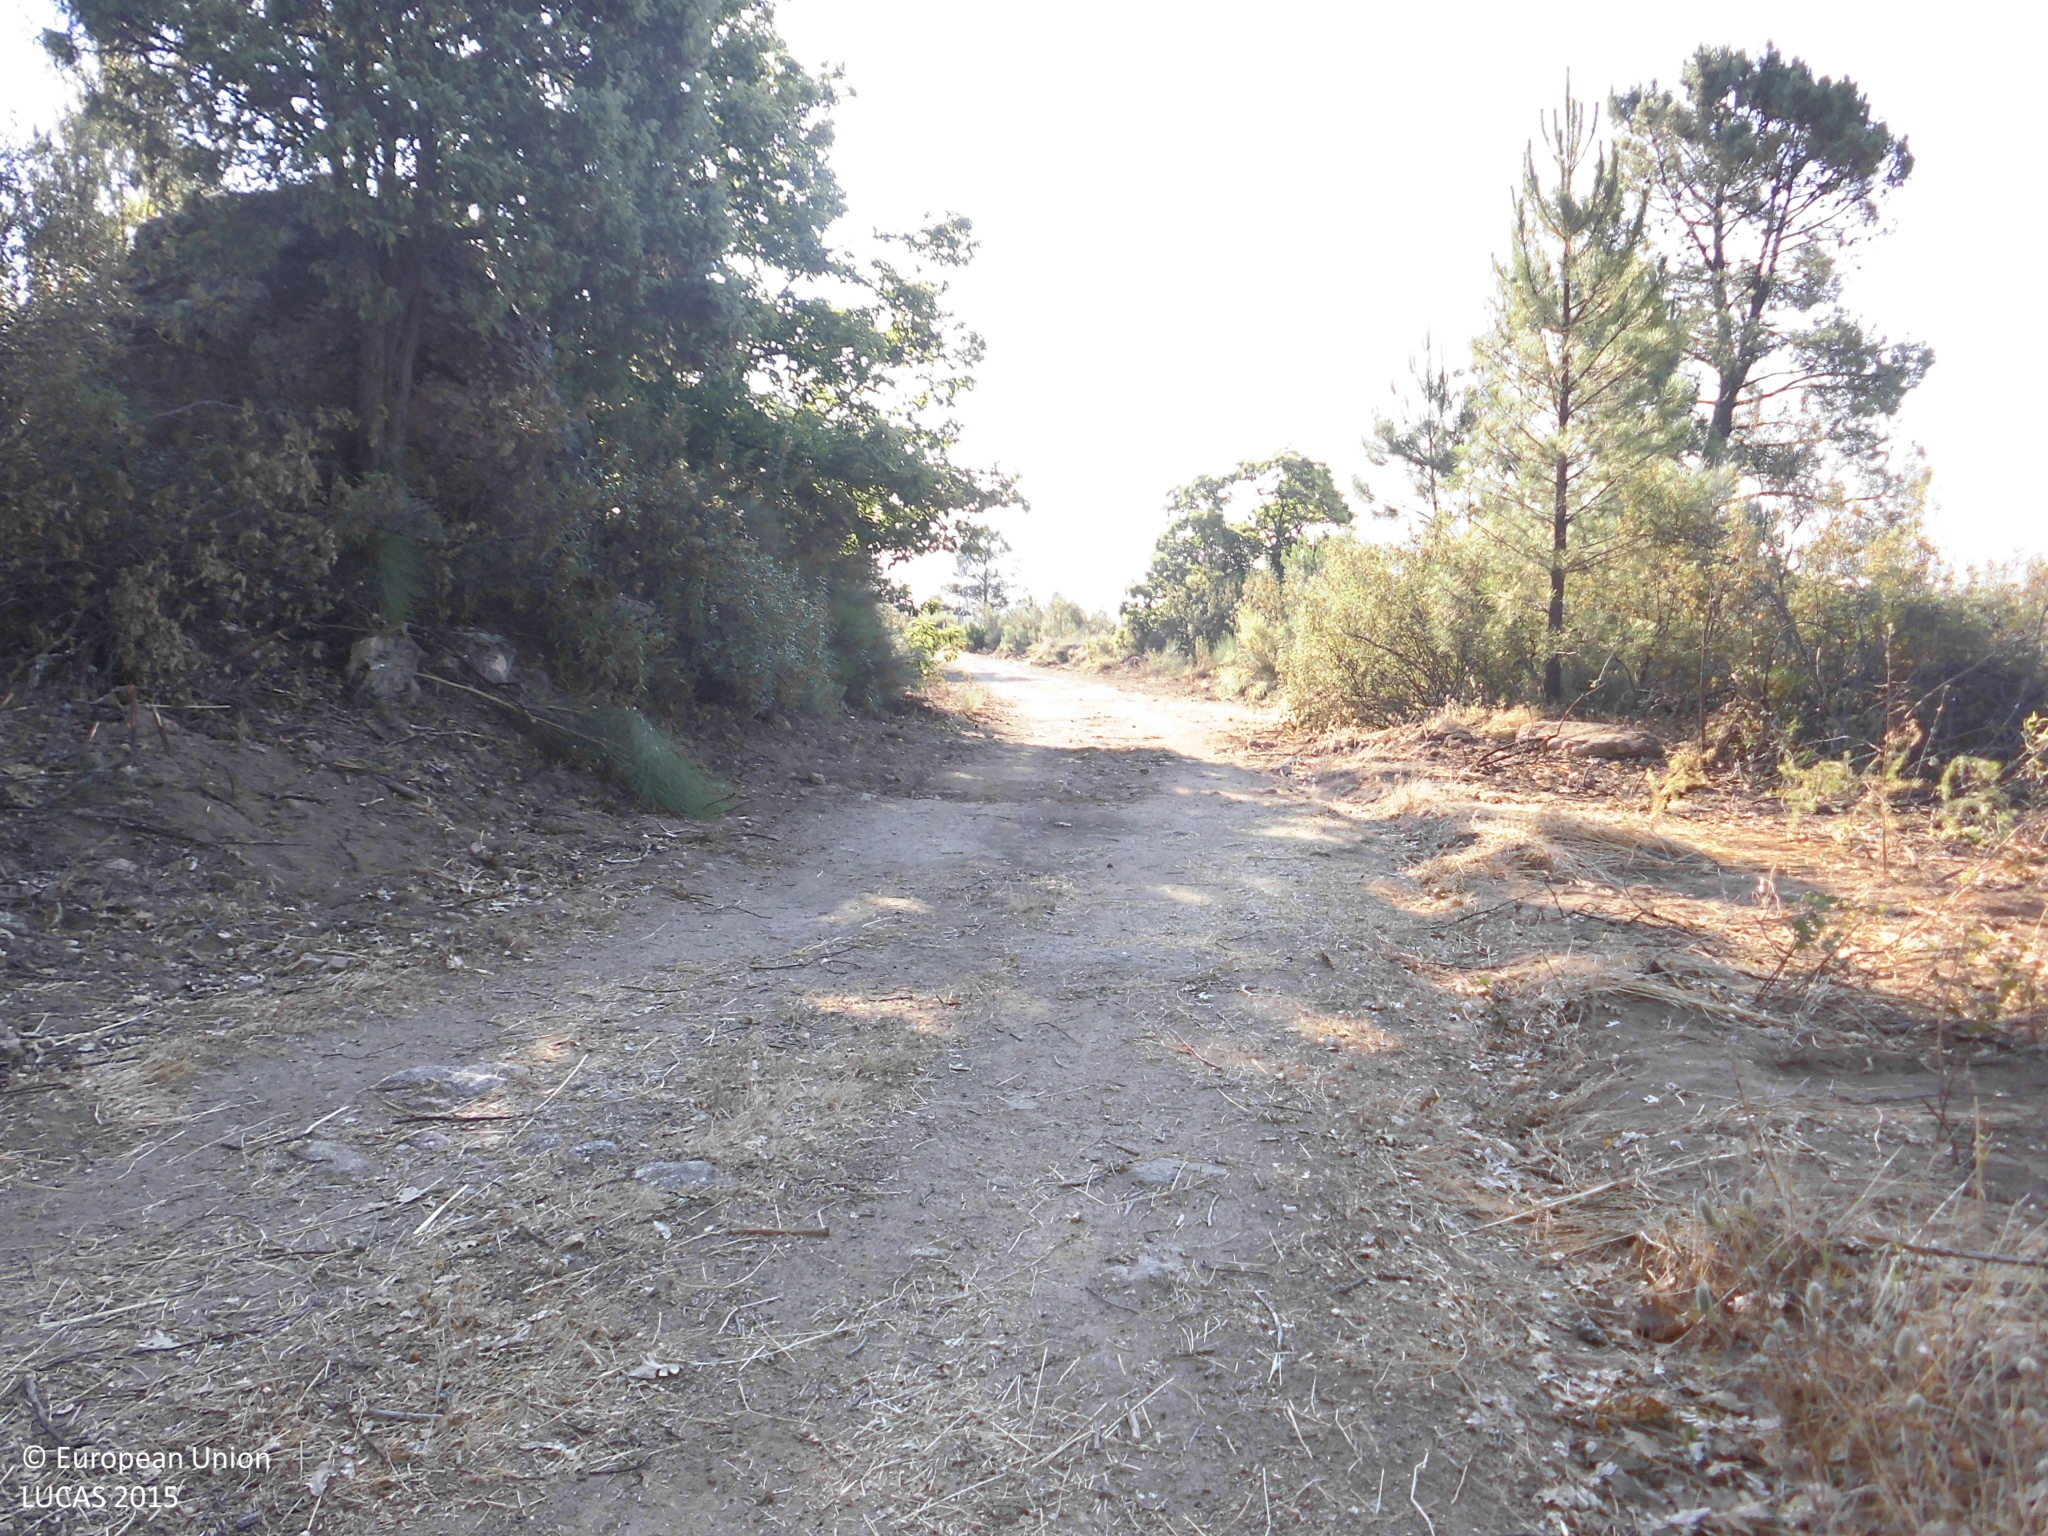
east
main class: Shrubland
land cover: Shrubland with sparse tree cover
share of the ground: > 75 %
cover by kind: shrubs 75 %, herbaceous plants 20 %, broadleaved forest trees 5 %
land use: Residential
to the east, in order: Shrubland with sparse tree cover; Pine dominated mixed woodland; Other structural elements; Electric lines; Pine dominated mixed woodland; Artificial constructions in urban areas; Other mixed woodland; Fences; Other bare soil
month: June
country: ES
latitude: 40.1383
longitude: -5.4481
